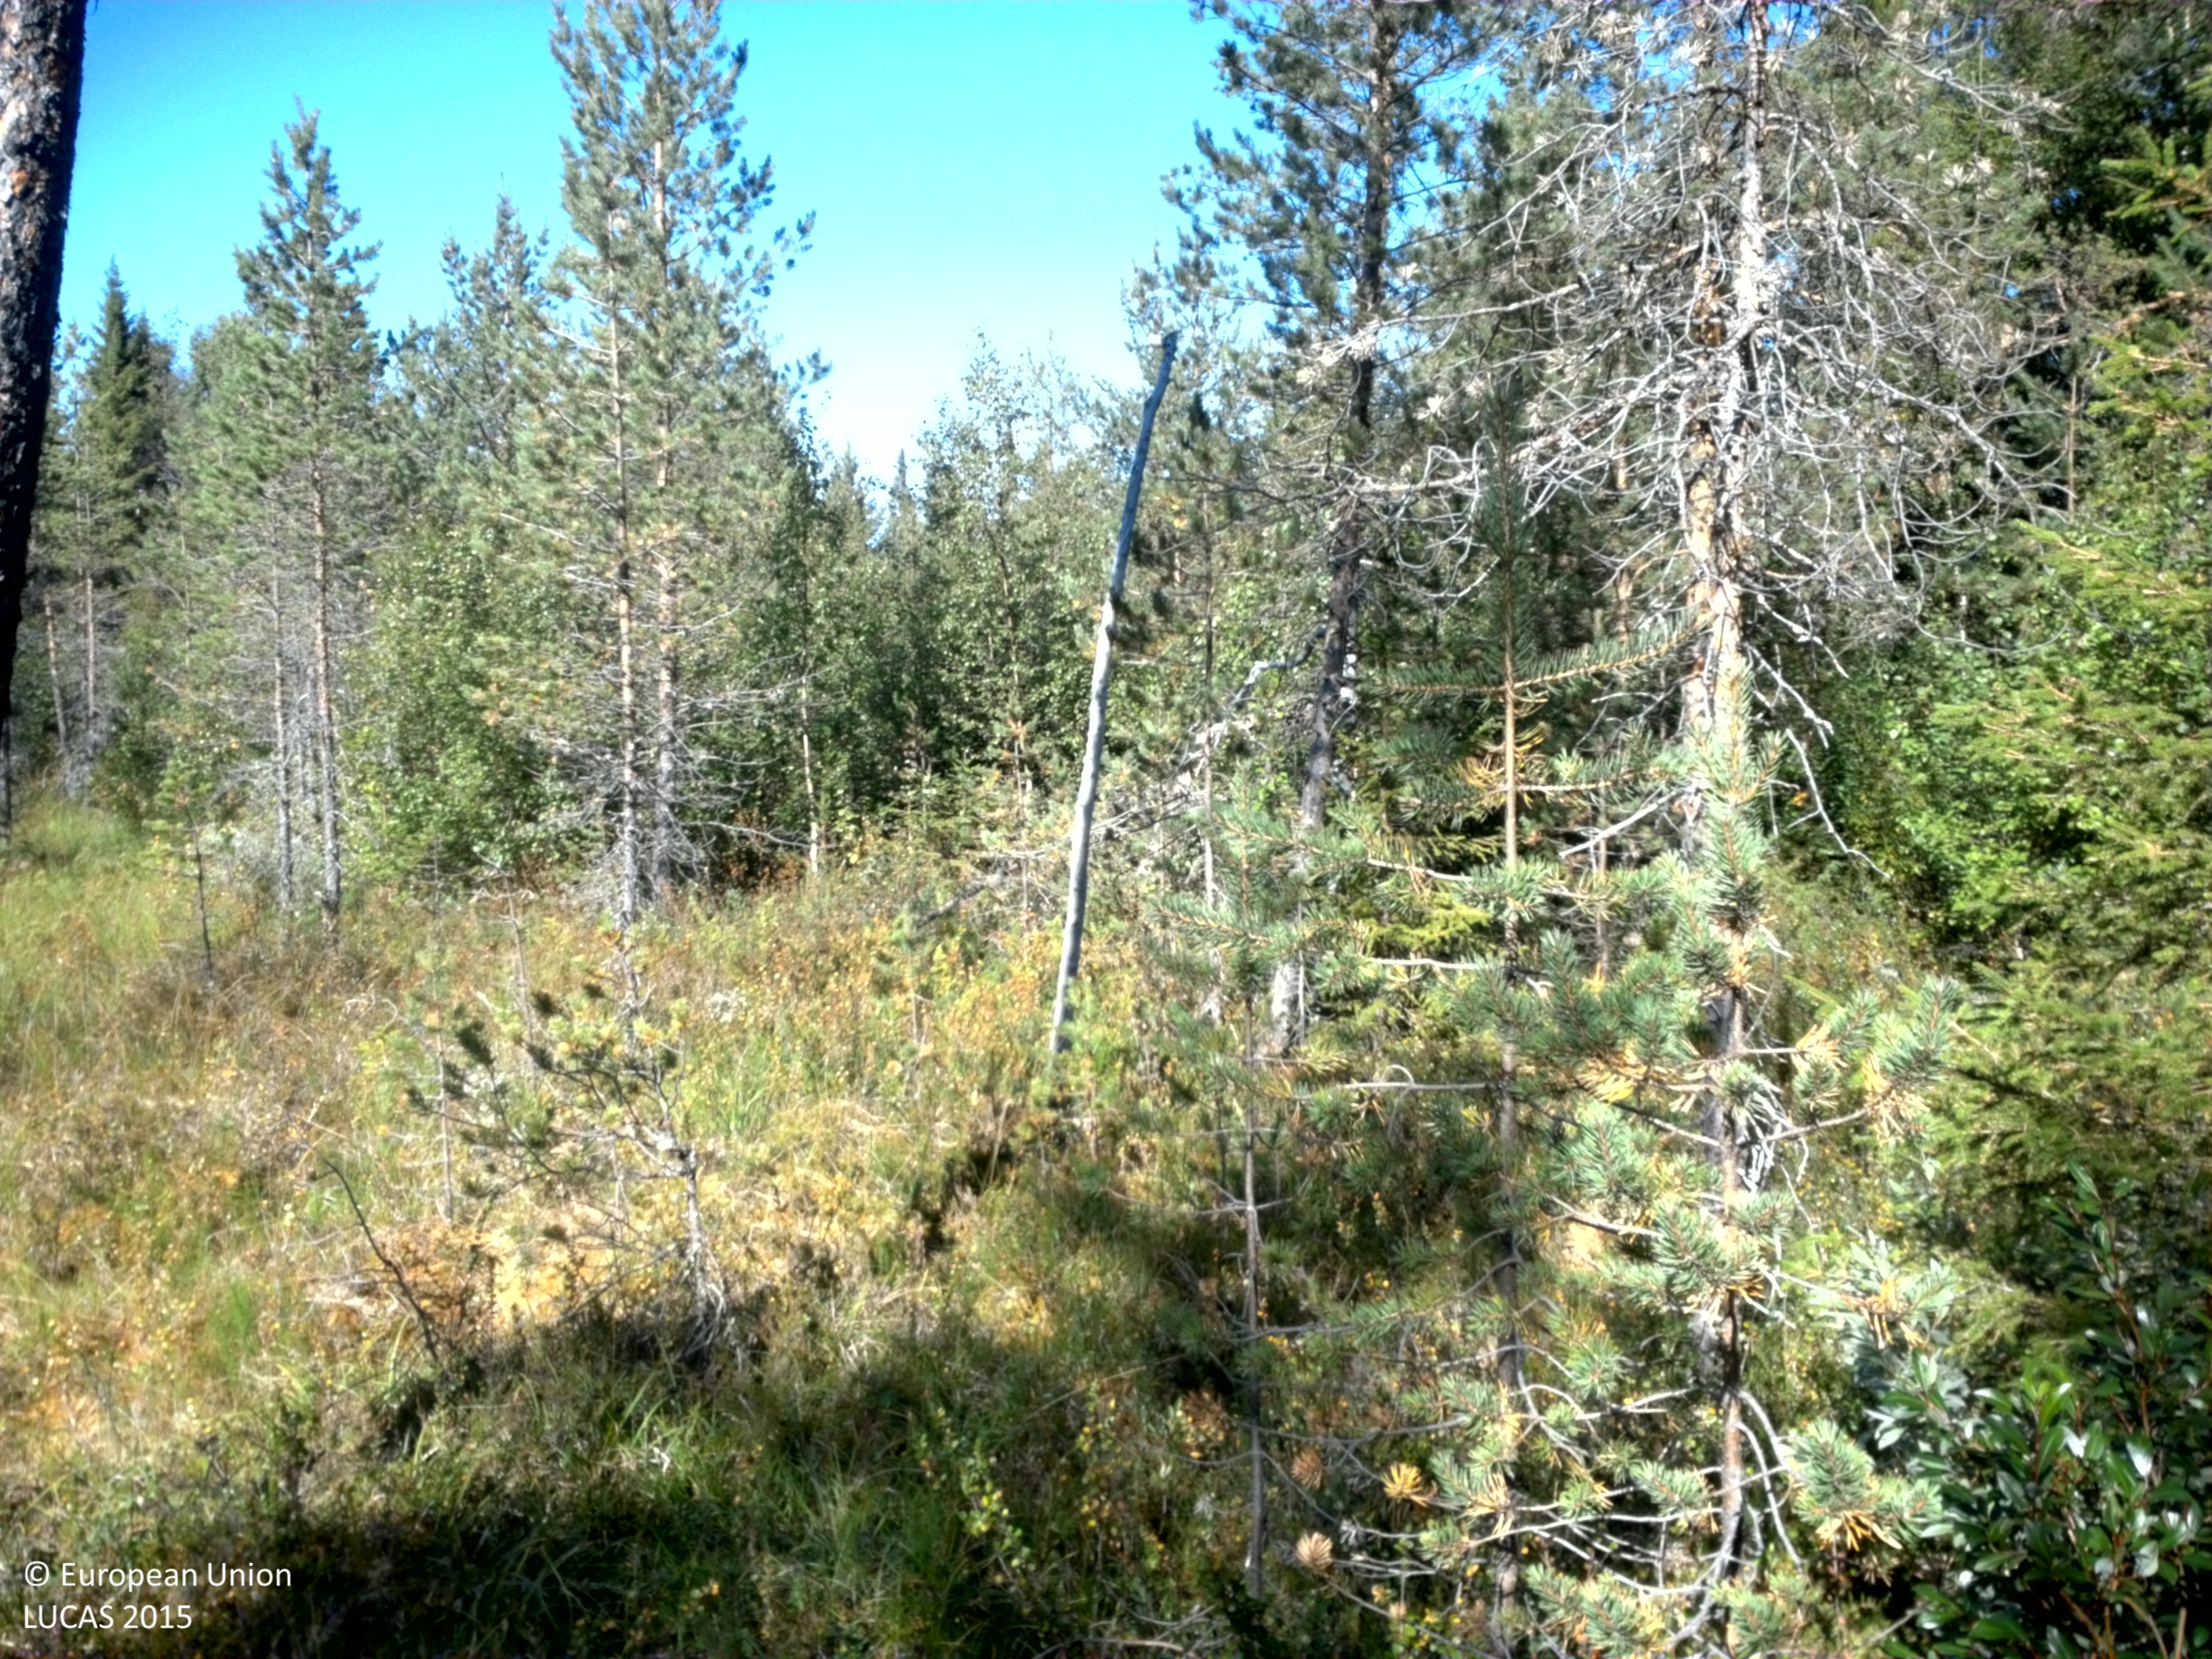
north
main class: Woodland
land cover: Pine dominated coniferous woodland
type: mire and swamp forests
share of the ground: 10 - 25 %
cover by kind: shrubs 45 %, coniferous forest trees 20 %, herbaceous plants 20 %, lichens and mosses 15 %
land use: Semi-natural and natural areas not in use
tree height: > 5 m
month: August
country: SE
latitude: 64.6483
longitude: 16.4350
